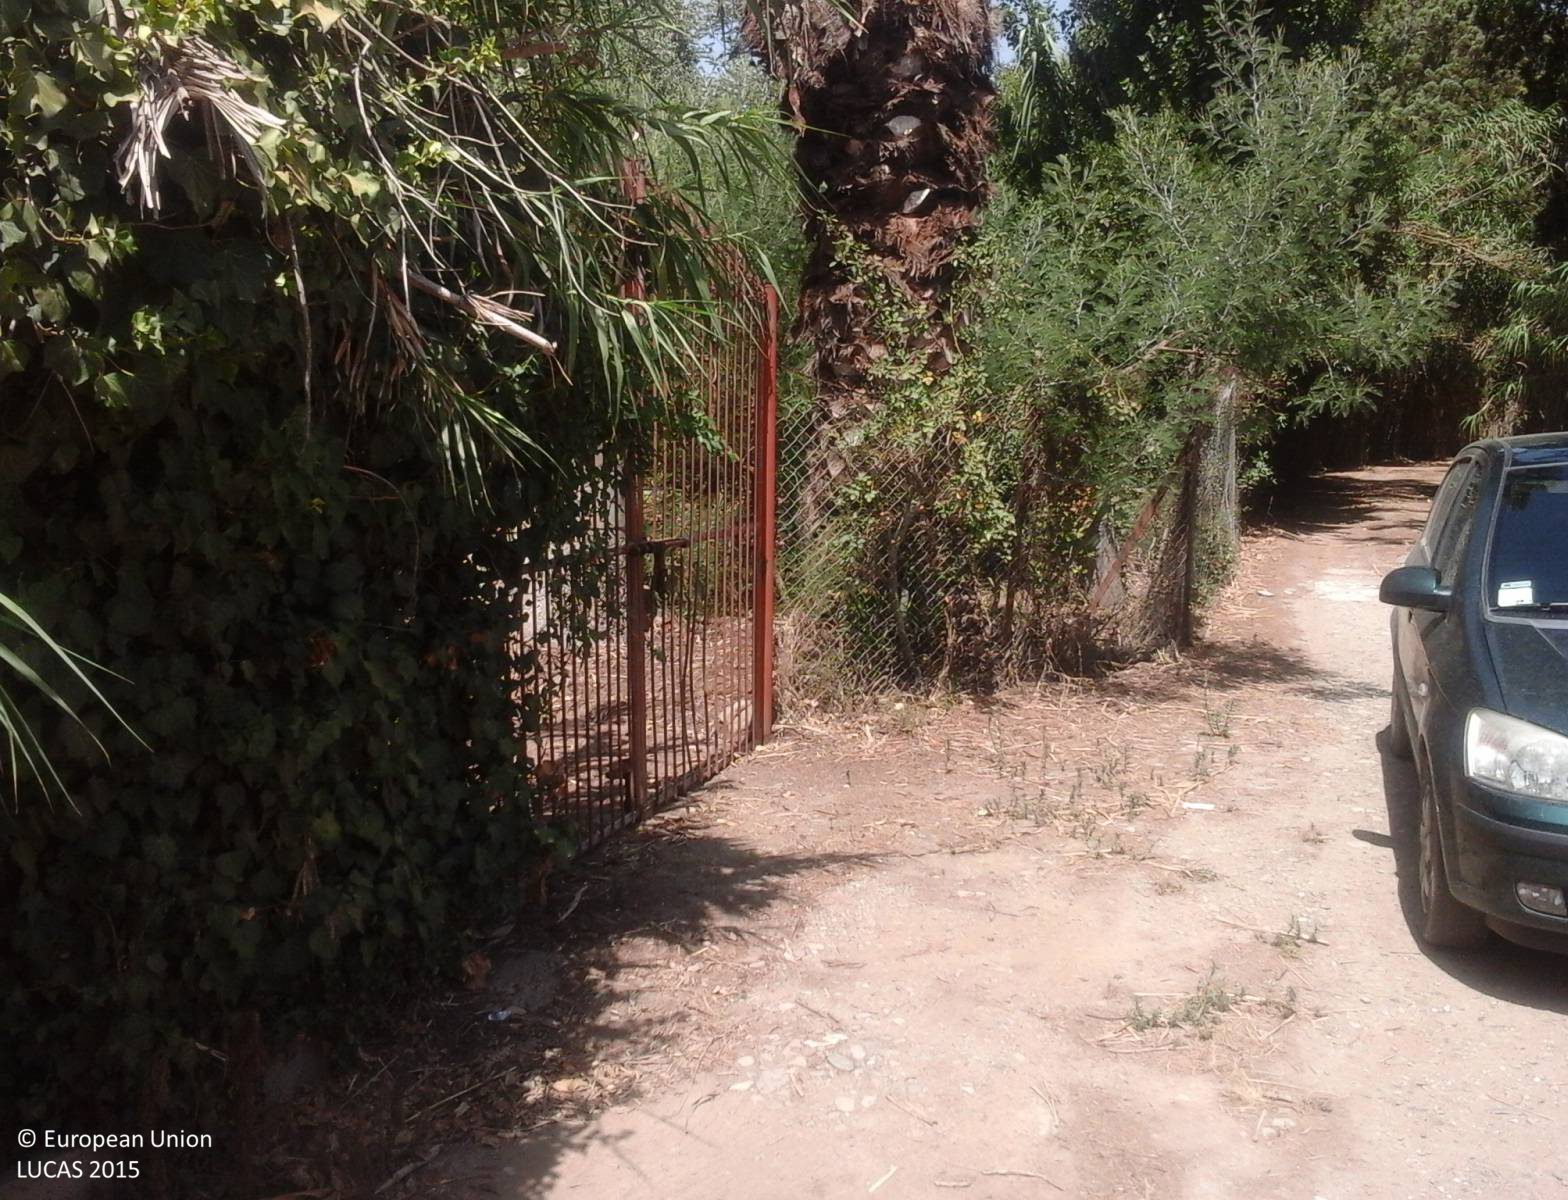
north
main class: Cropland
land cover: Oranges
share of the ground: > 75 %
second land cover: Grassland without tree/shrub cover
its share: > 75 %
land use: Agriculture (excluding fallow land and kitchen gardens)
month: August
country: IT
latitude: 39.4281
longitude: 8.9030
